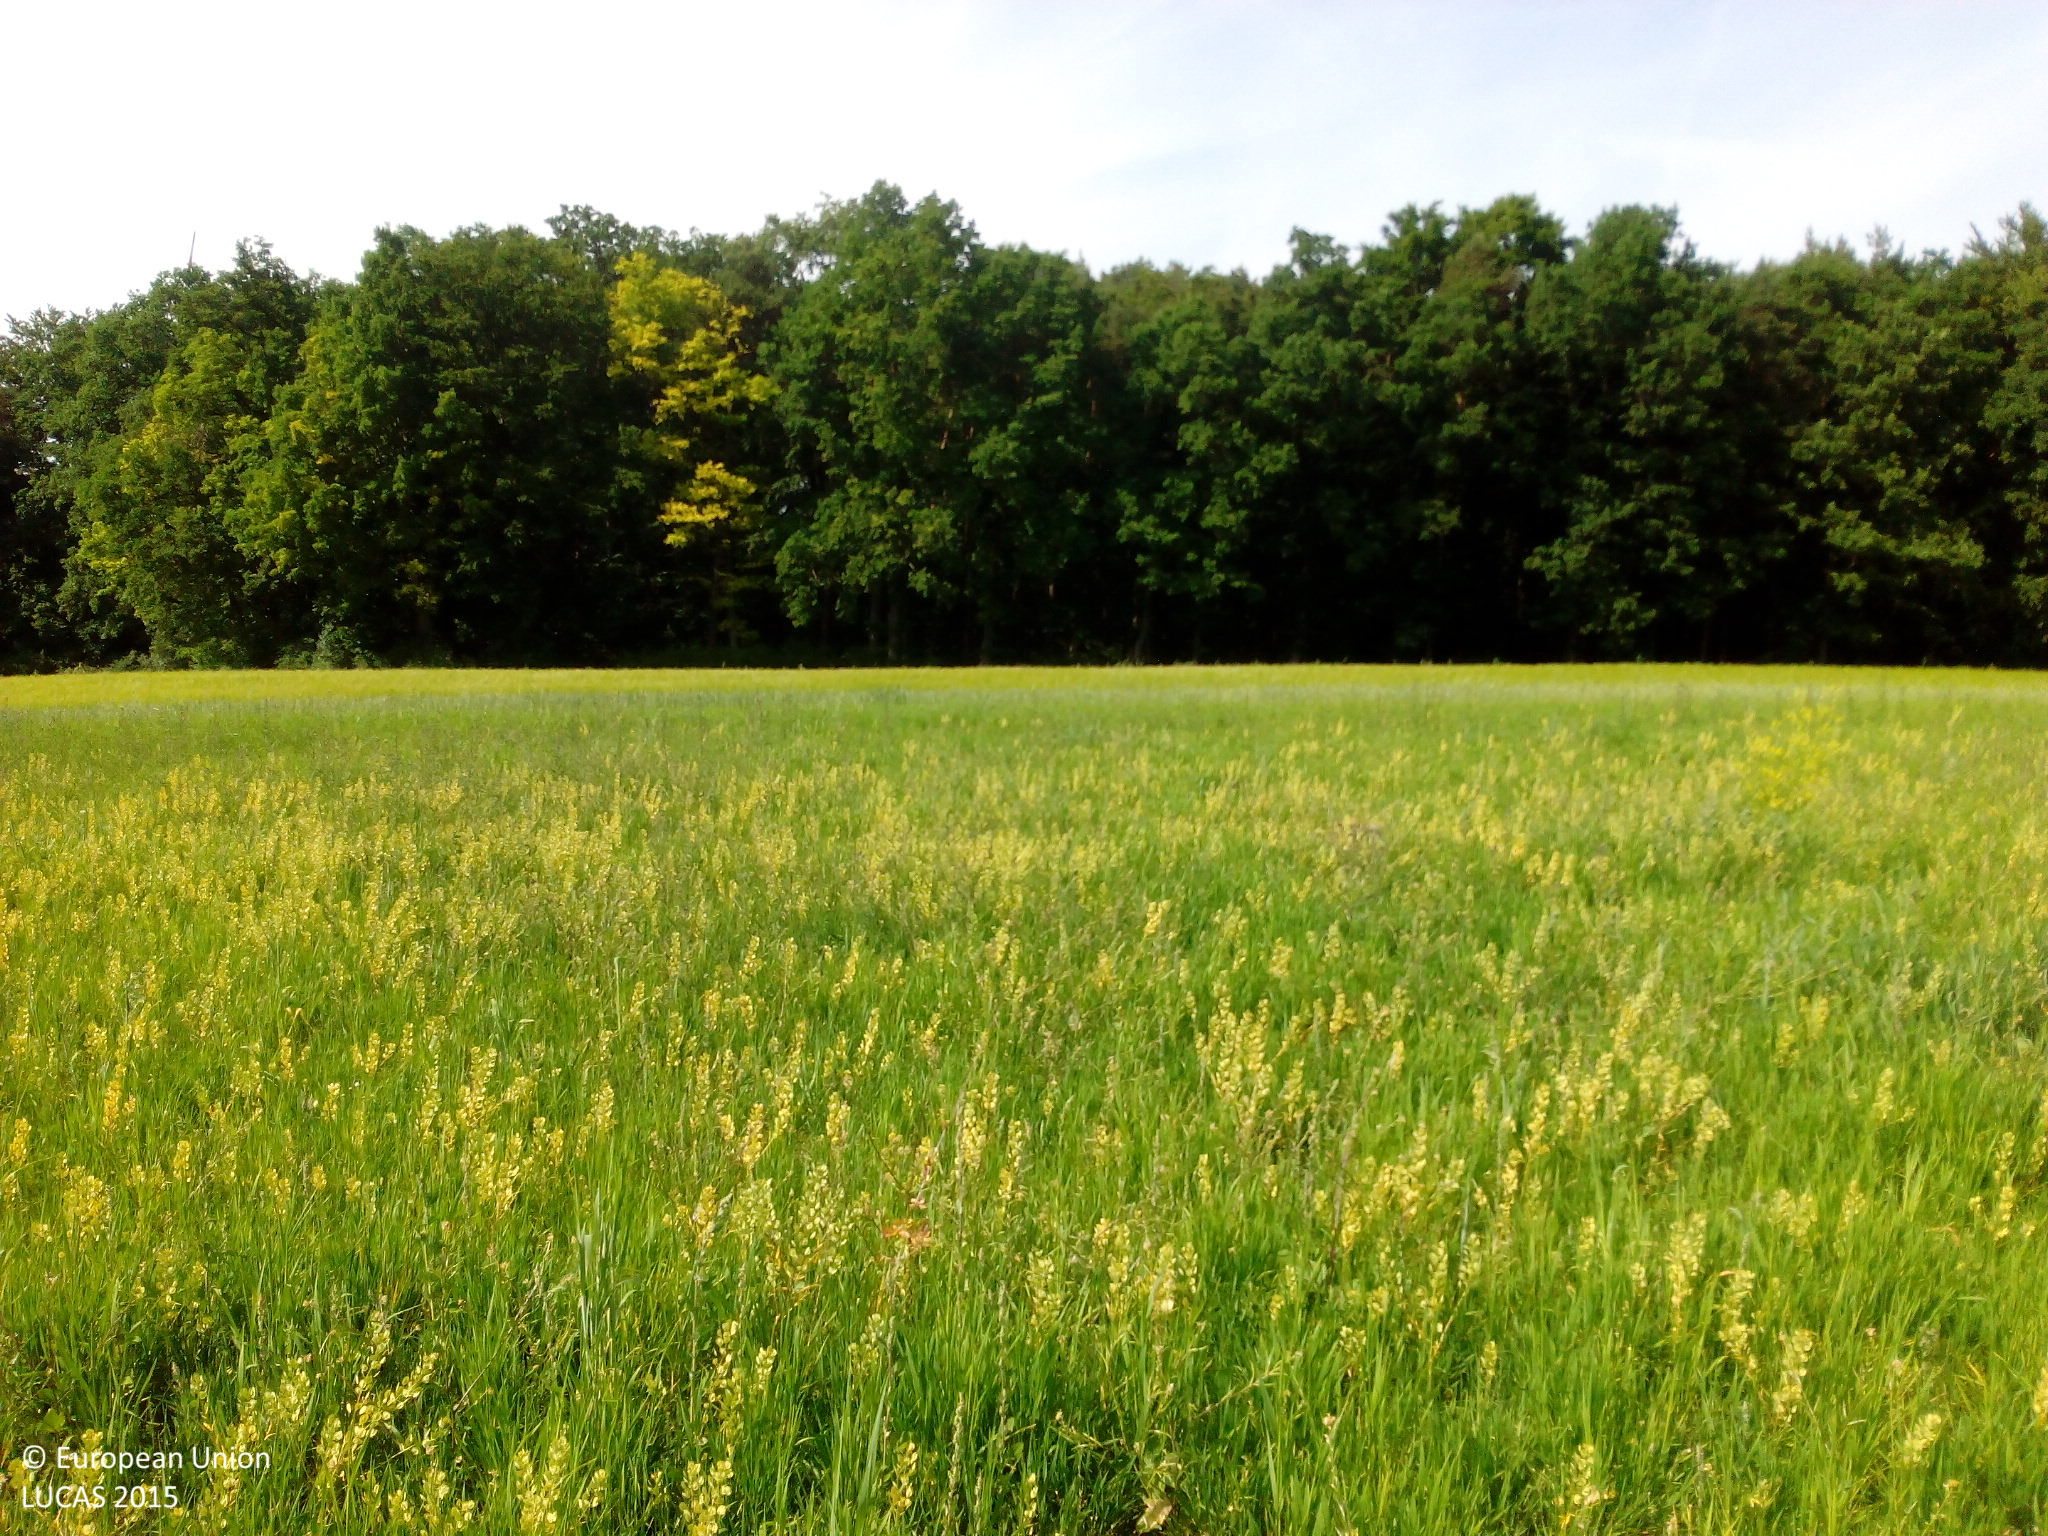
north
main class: Cropland
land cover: Common wheat
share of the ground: > 75 %
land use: Agriculture (excluding fallow land and kitchen gardens)
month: June
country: DE
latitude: 49.5000
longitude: 9.5721
